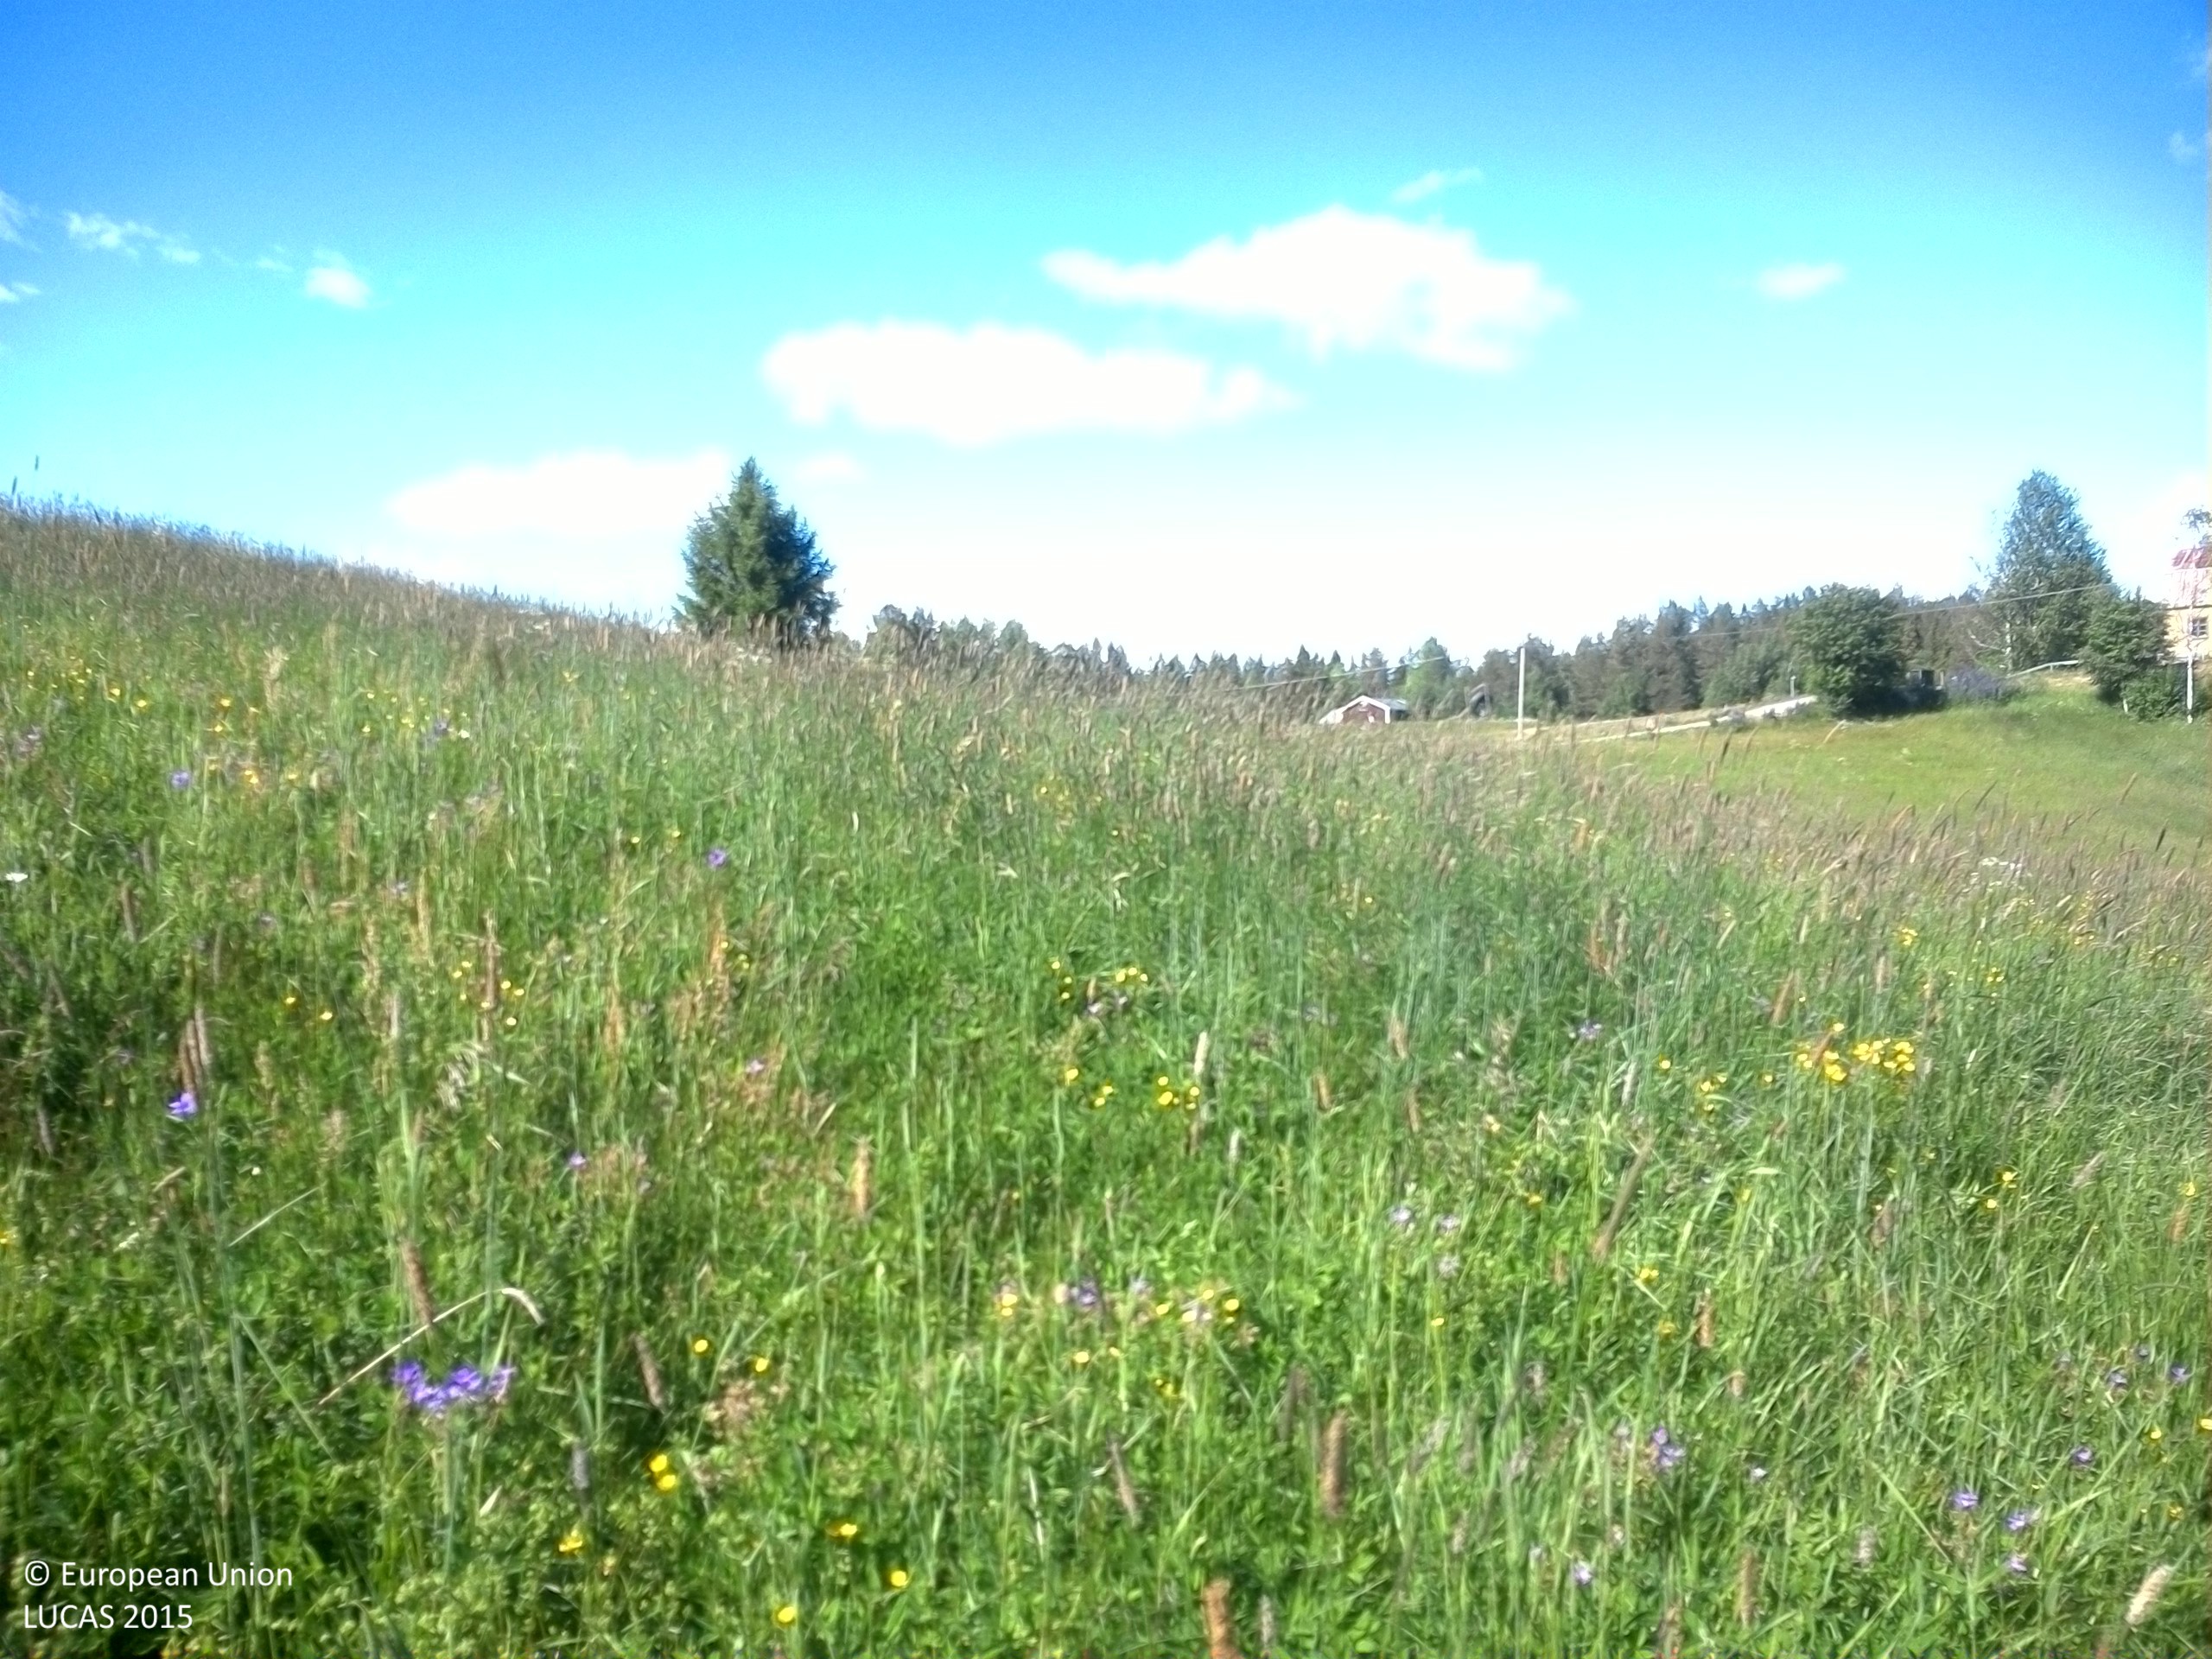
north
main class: Grassland
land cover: Grassland without tree/shrub cover
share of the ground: > 75 %
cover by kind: herbaceous plants 95 %, lichens and mosses 5 %
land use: Agriculture (excluding fallow land and kitchen gardens)
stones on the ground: < 10 %
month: June
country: SE
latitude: 62.8286
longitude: 17.7713
